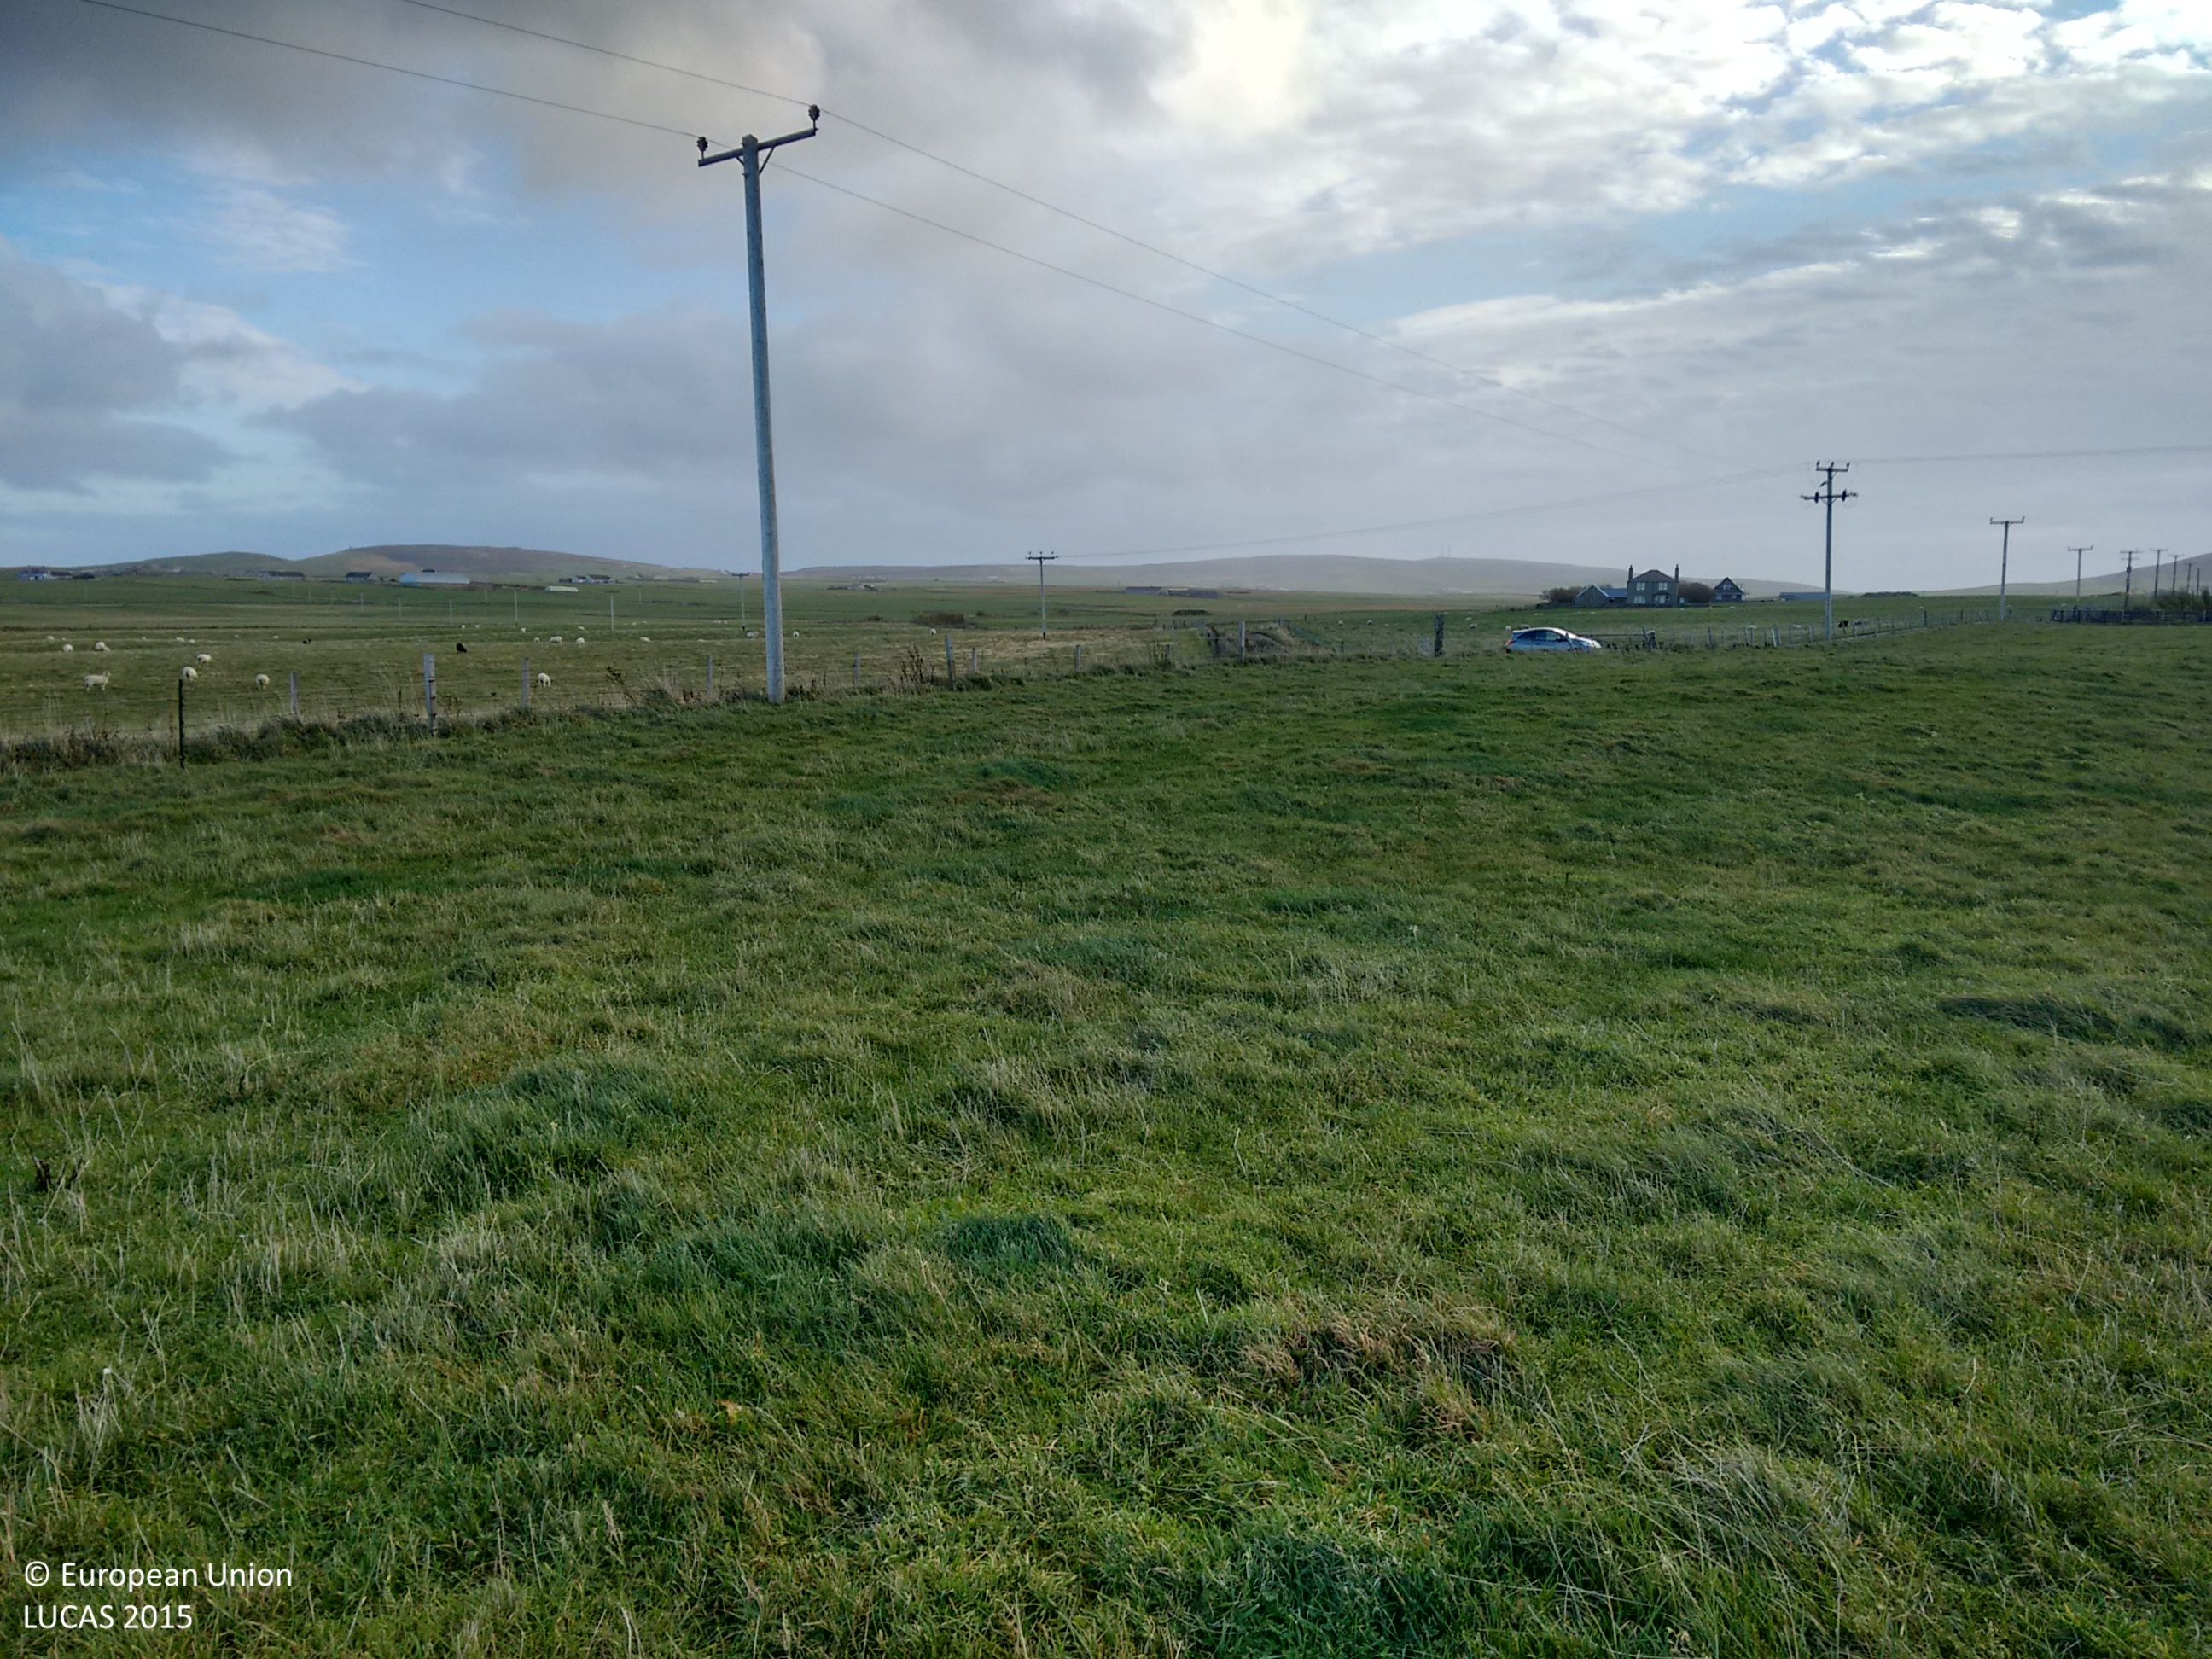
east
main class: Grassland
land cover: Grassland without tree/shrub cover
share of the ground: > 75 %
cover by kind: herbaceous plants 100 %
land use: Agriculture (excluding fallow land and kitchen gardens)
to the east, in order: Grassland without tree/shrub cover; Electric lines; Fences; Grassland without tree/shrub cover; Fences; Grass margins; Paved roads, cycling and walking lanes; Grass margins; Fences; Grassland without tree/shrub cover
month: November
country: GB
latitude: 58.9903
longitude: -3.1948
